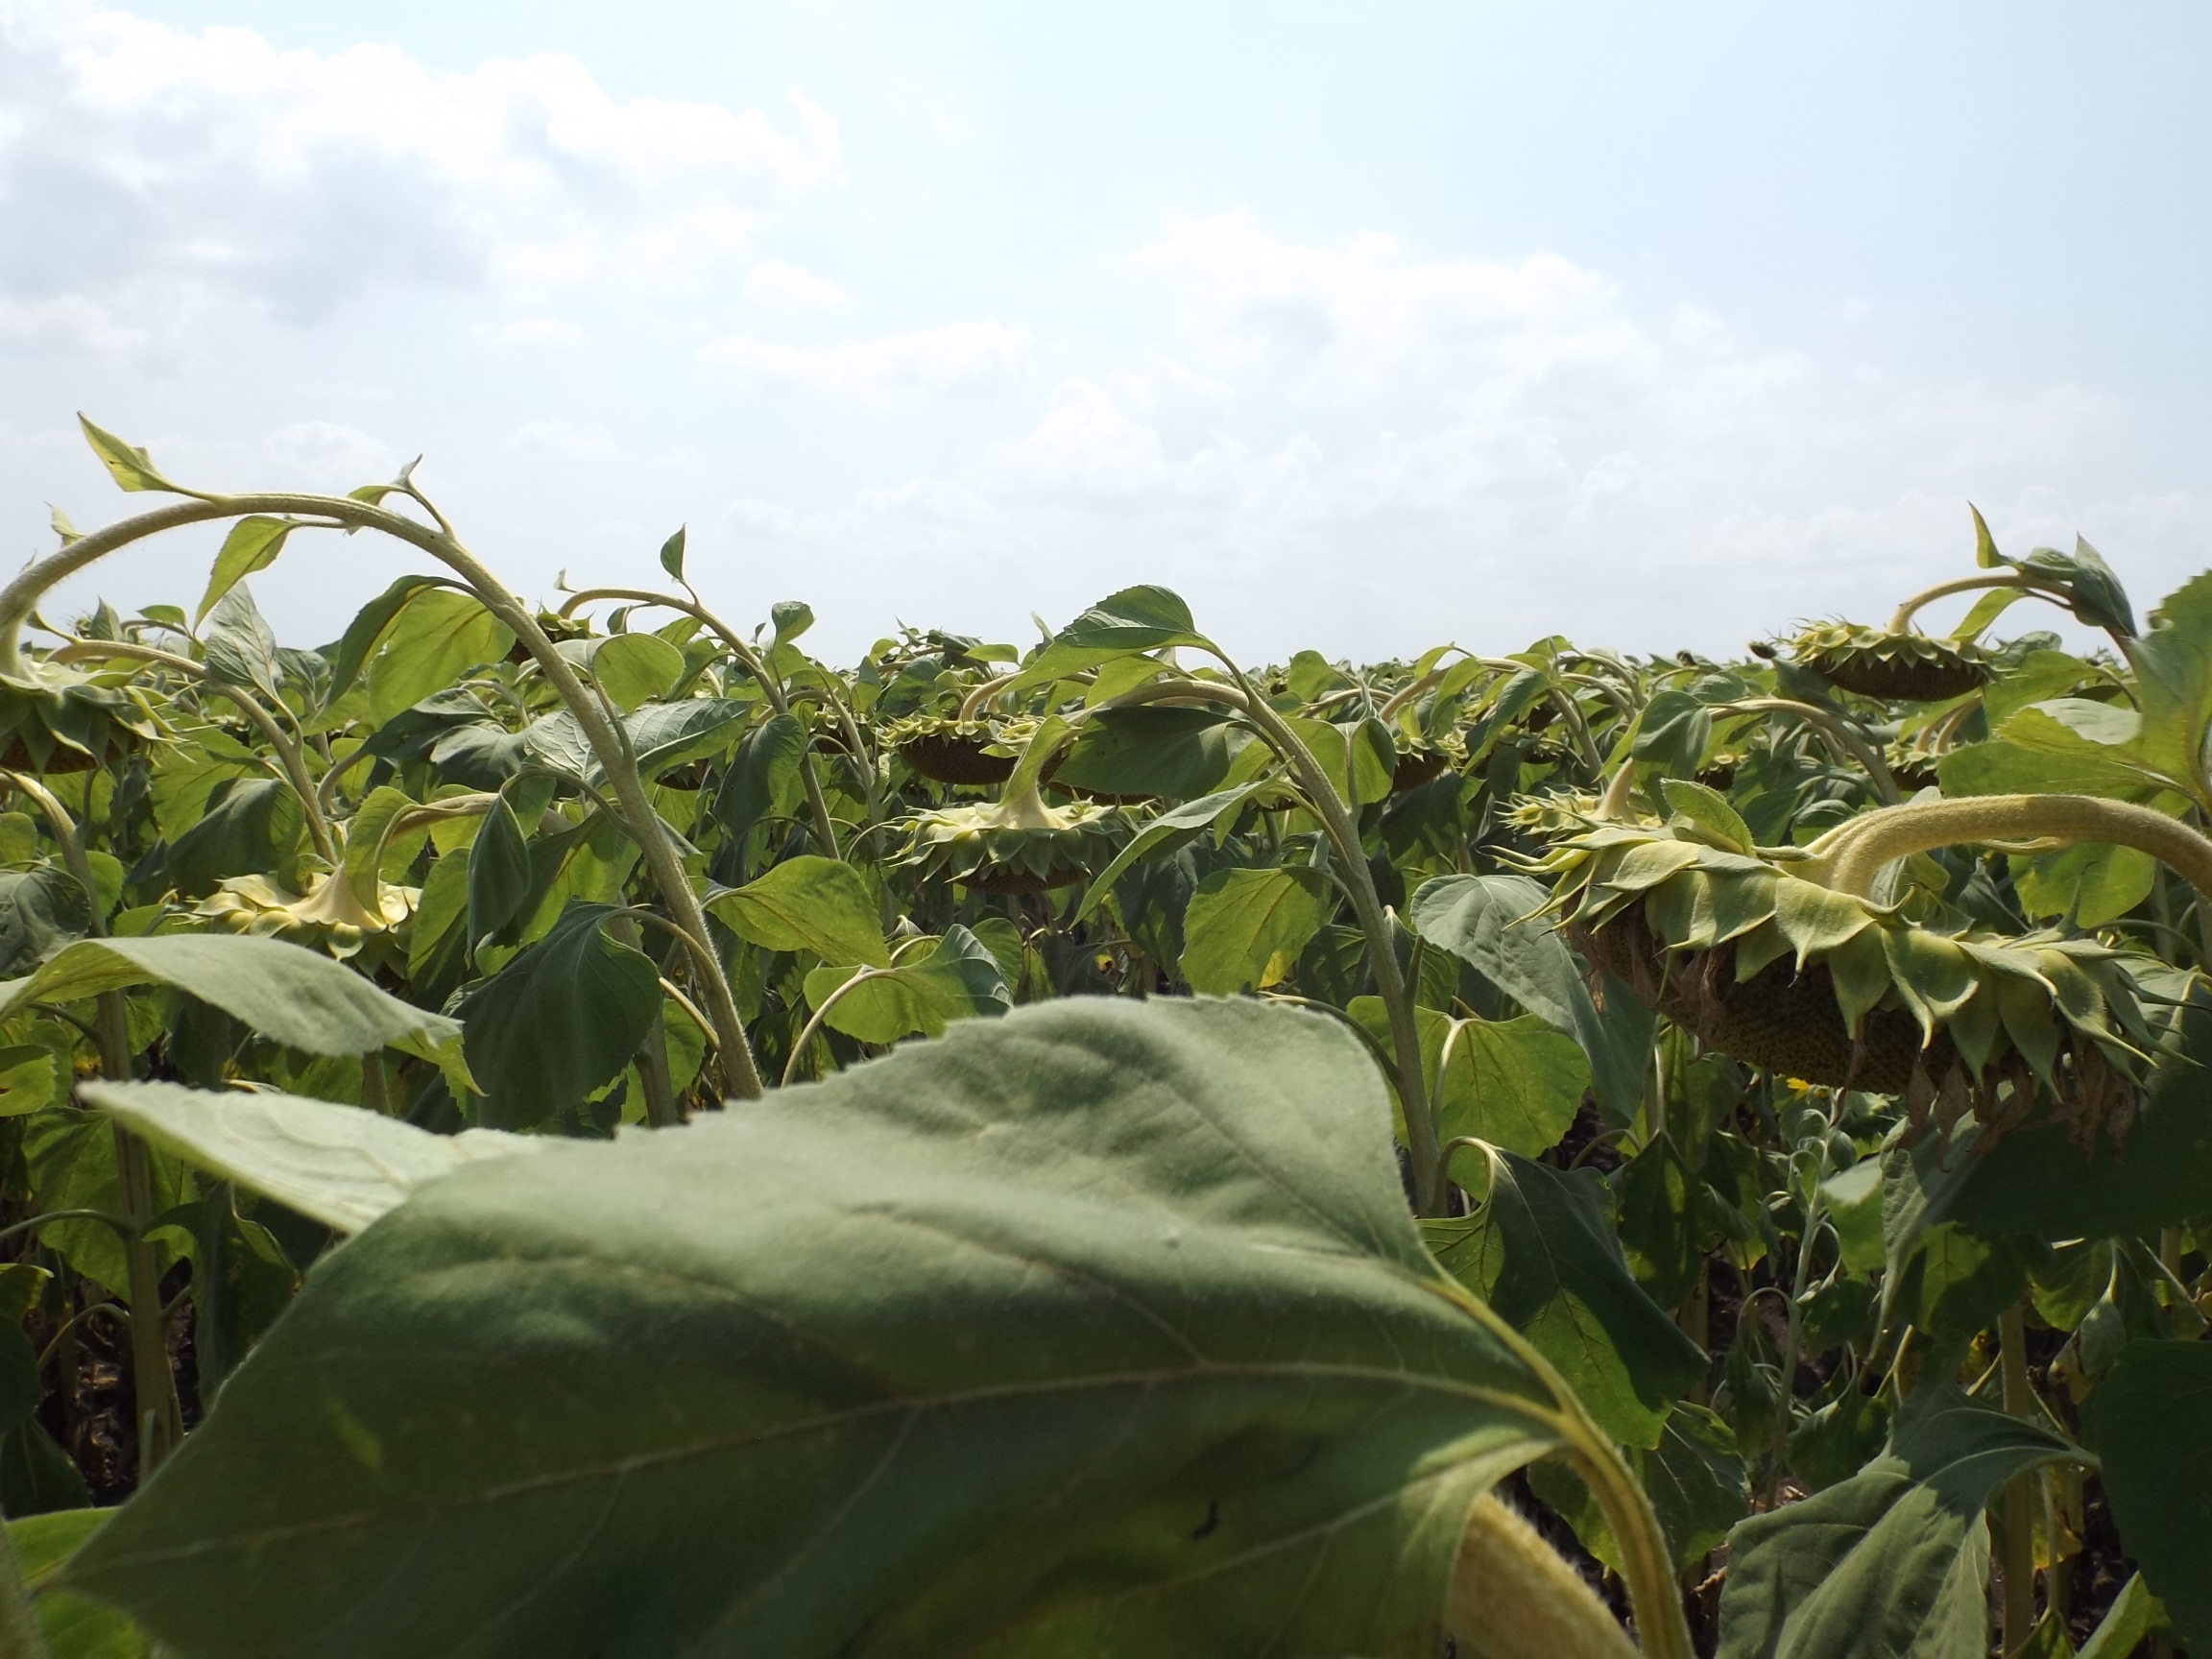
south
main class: Cropland
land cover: Sunflower
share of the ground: > 75 %
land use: Agriculture (excluding fallow land and kitchen gardens)
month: July
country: BG
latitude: 43.4623
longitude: 27.4705
